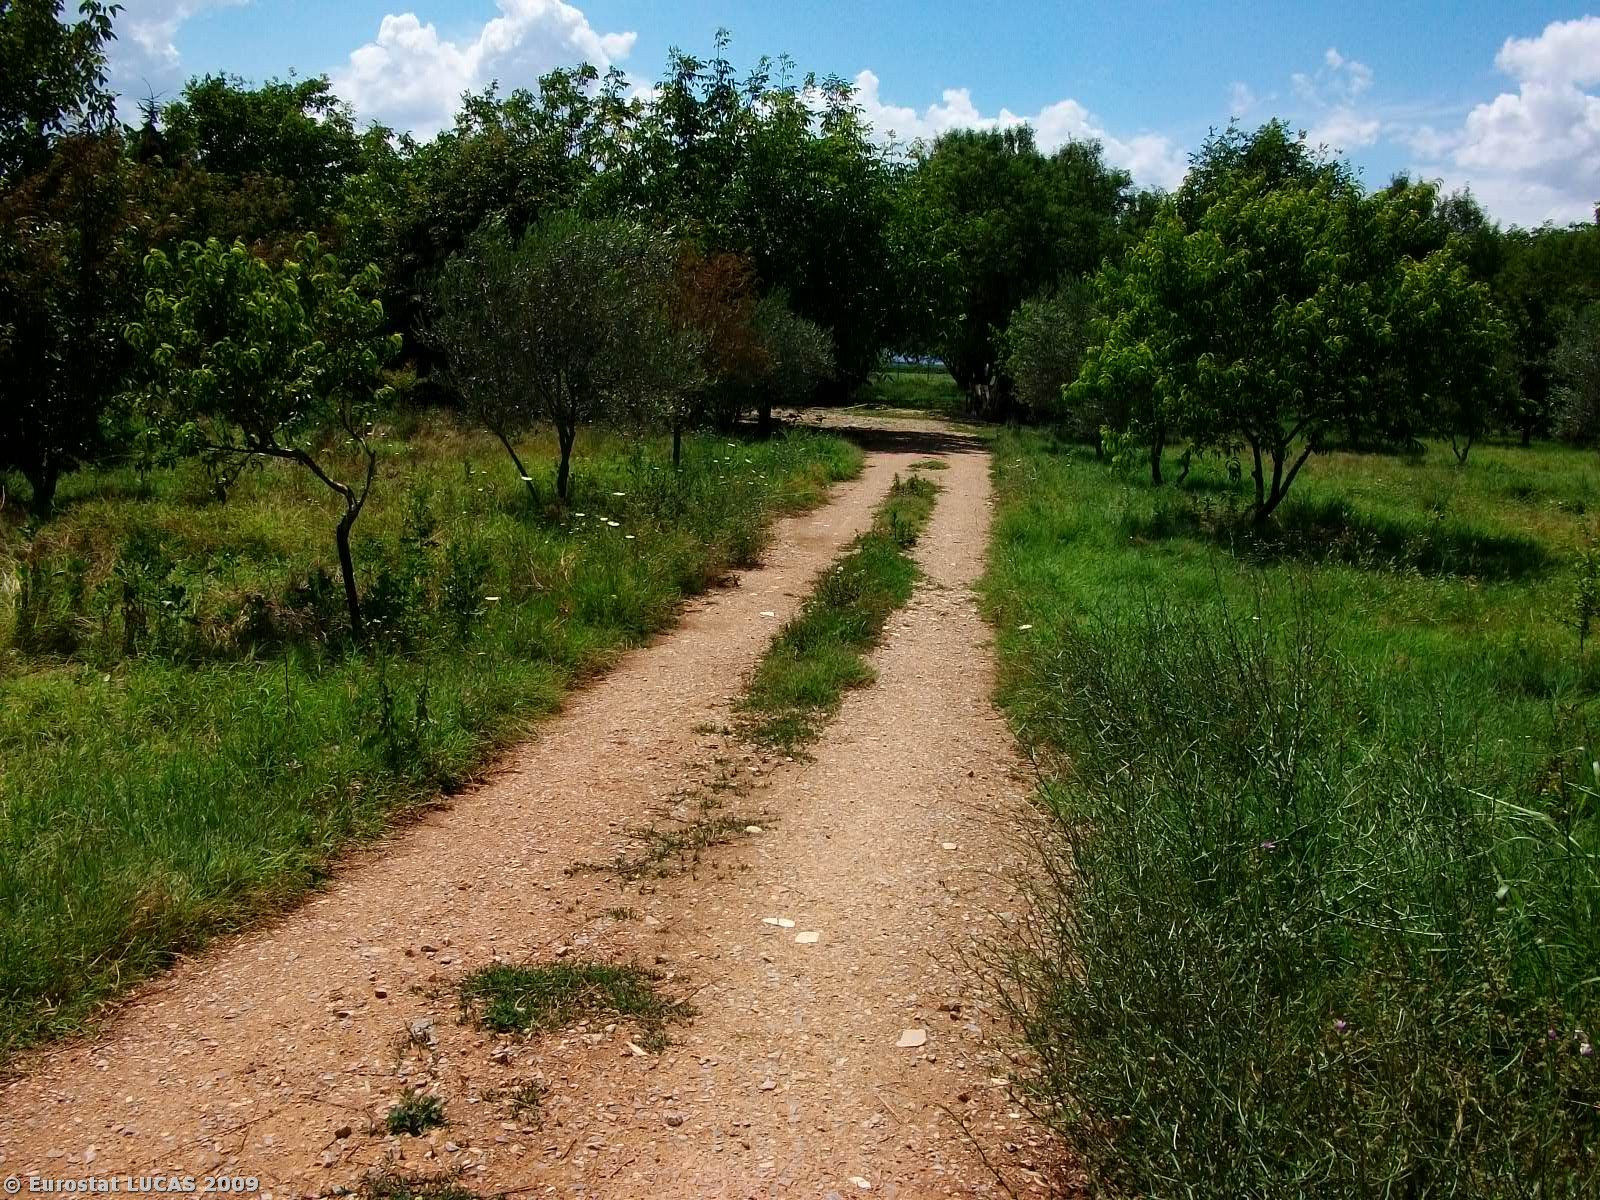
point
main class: Cropland
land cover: Nuts trees
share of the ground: 50 - 75 %
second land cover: Grassland with sparse tree/shrub cover
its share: > 75 %
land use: Kitchen garden
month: June
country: GR
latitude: 41.1493
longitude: 24.1008
